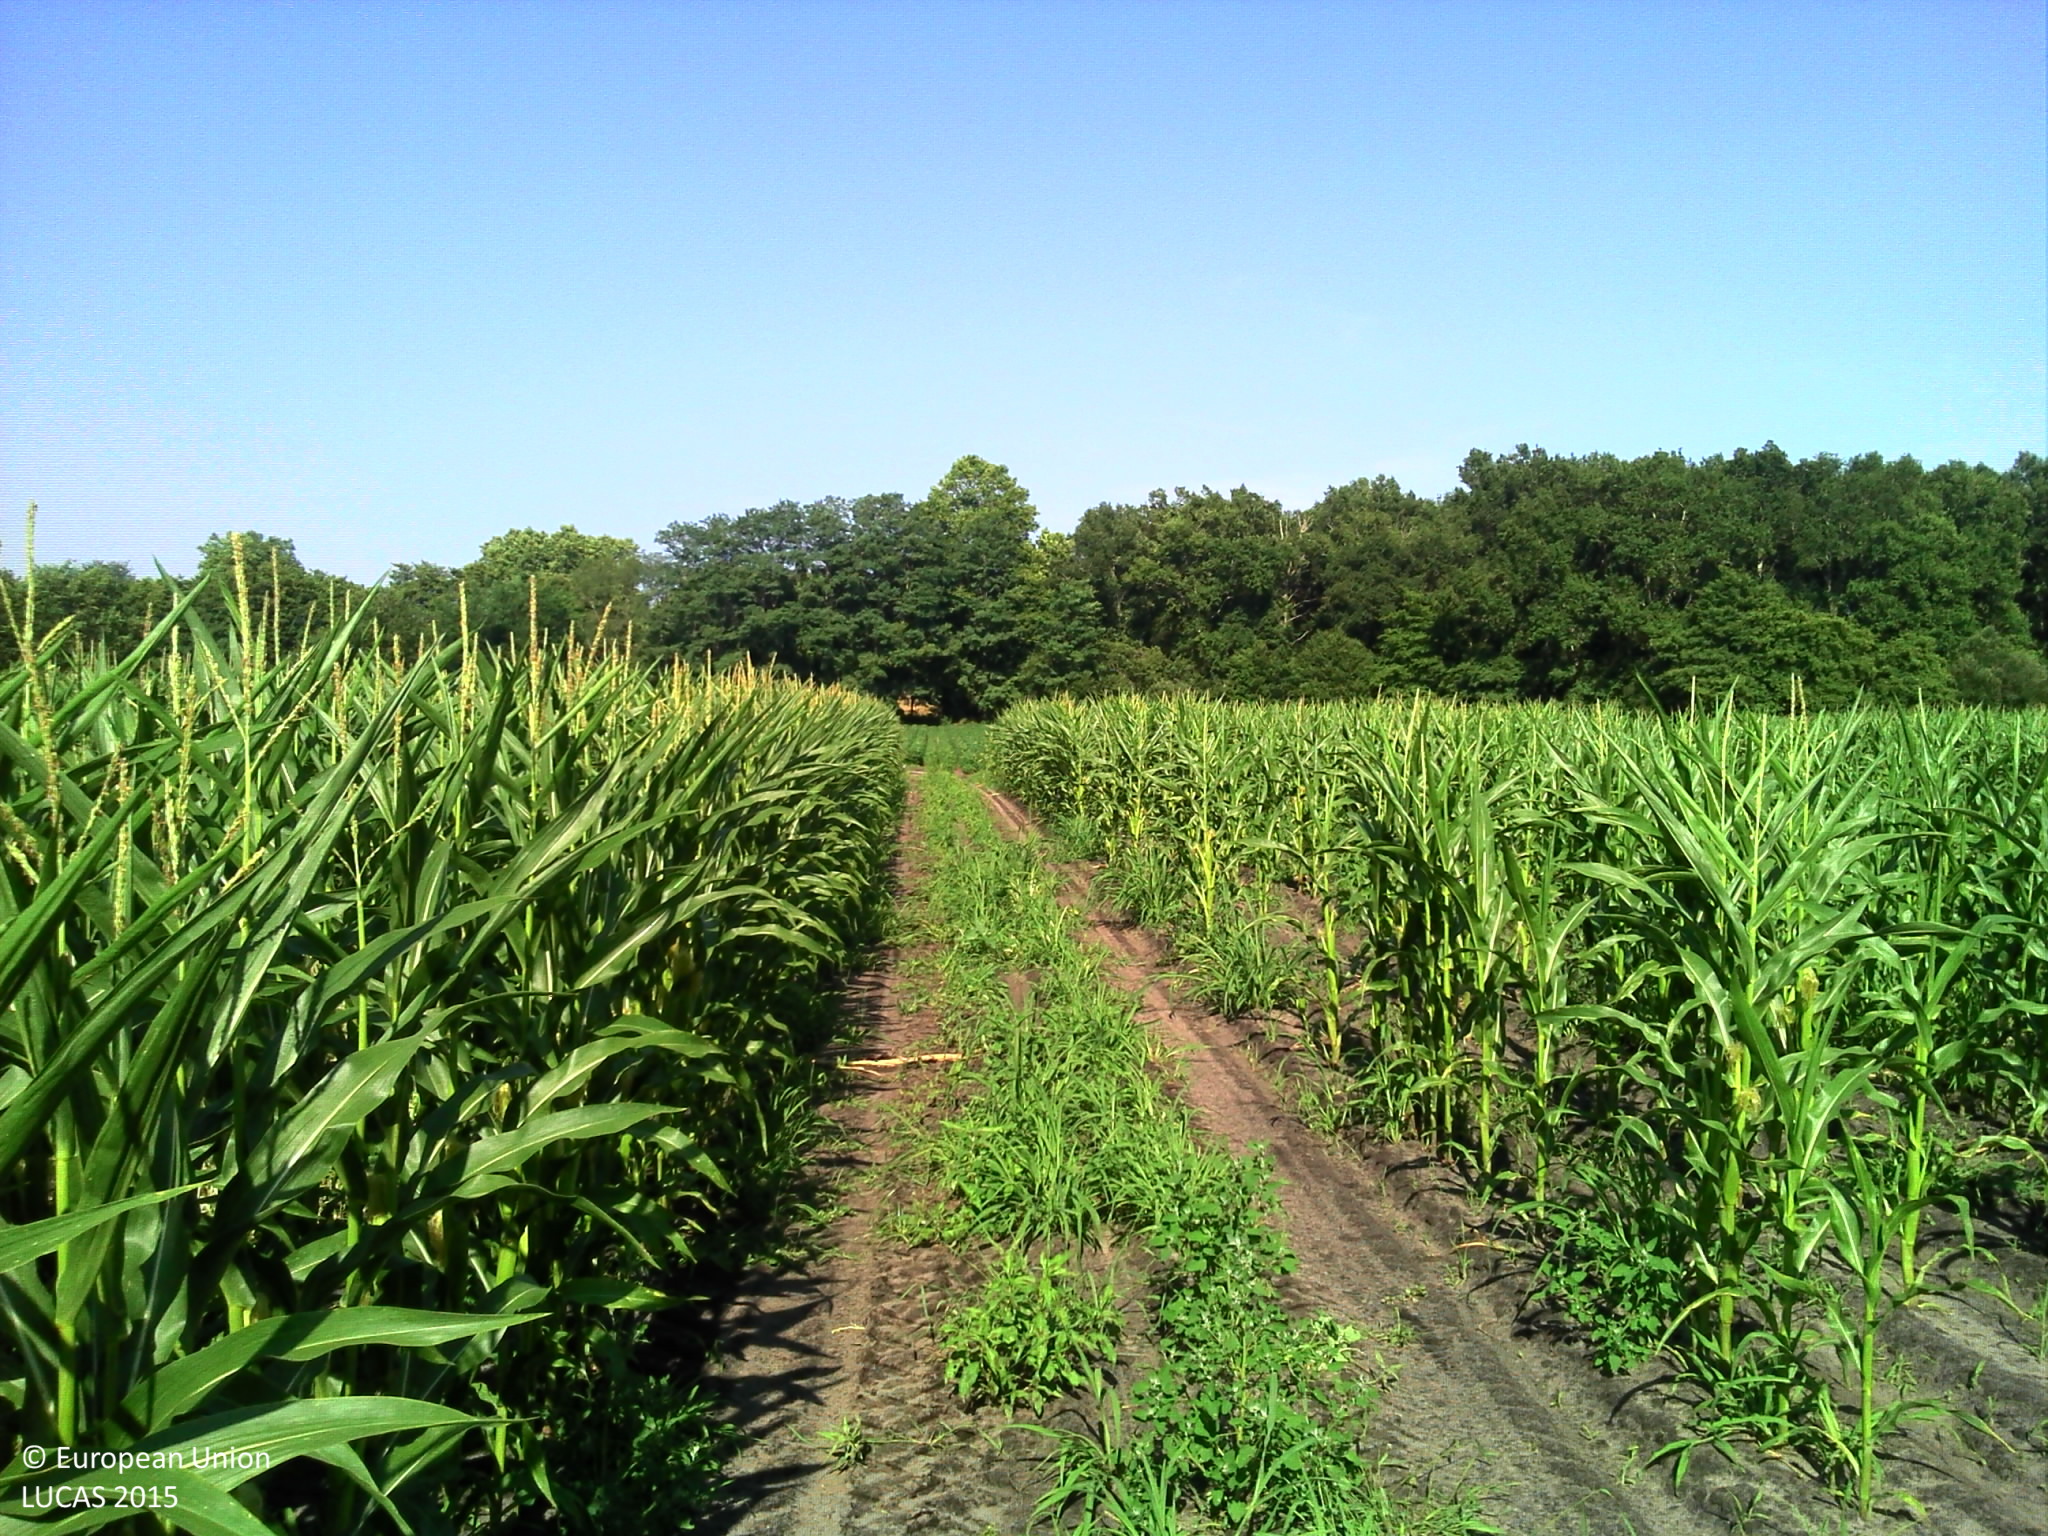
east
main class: Cropland
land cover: Maize
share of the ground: > 75 %
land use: Agriculture (excluding fallow land and kitchen gardens)
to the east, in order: Maize; Tracks; Grassland without tree/shrub cover; Broadleaved woodland; Rivers and streams; Tracks; Broadleaved woodland
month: July
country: FR
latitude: 43.6882
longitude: -1.1948
